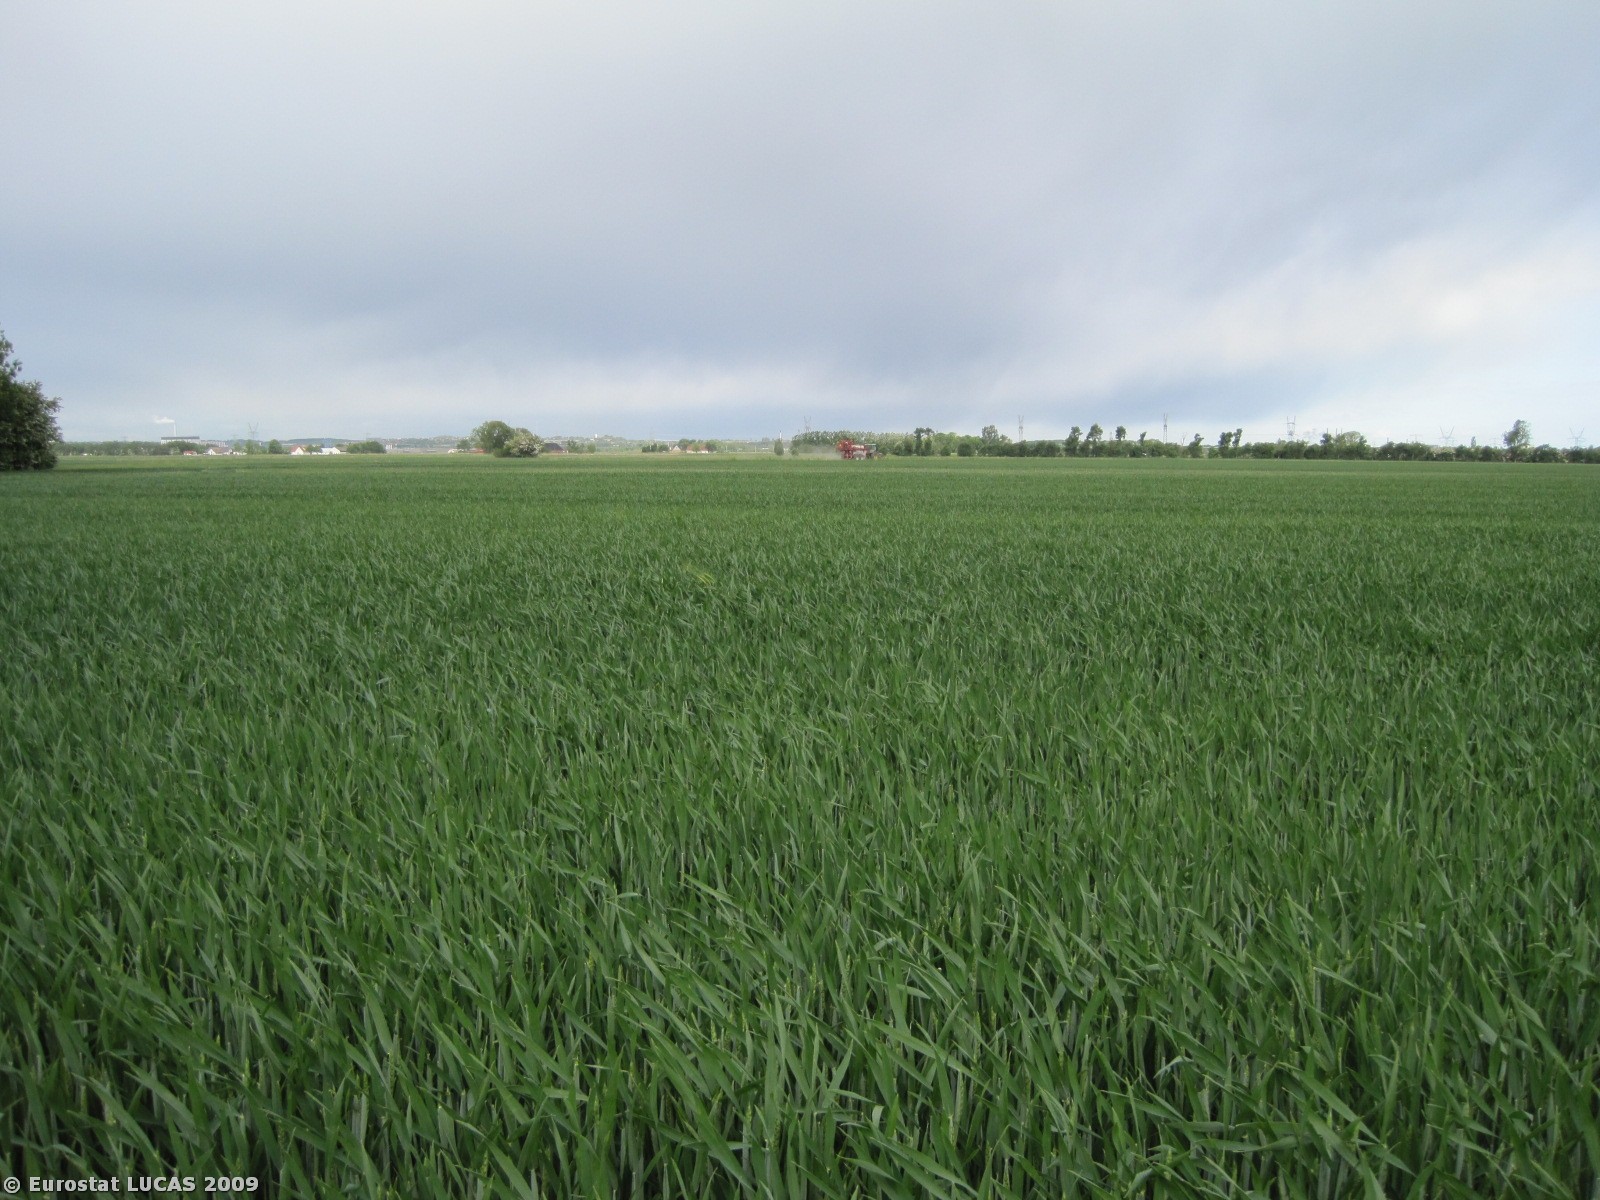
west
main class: Cropland
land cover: Common wheat
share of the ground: > 75 %
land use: Agriculture (excluding fallow land and kitchen gardens)
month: June
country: DK
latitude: 57.0326
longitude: 10.0823
